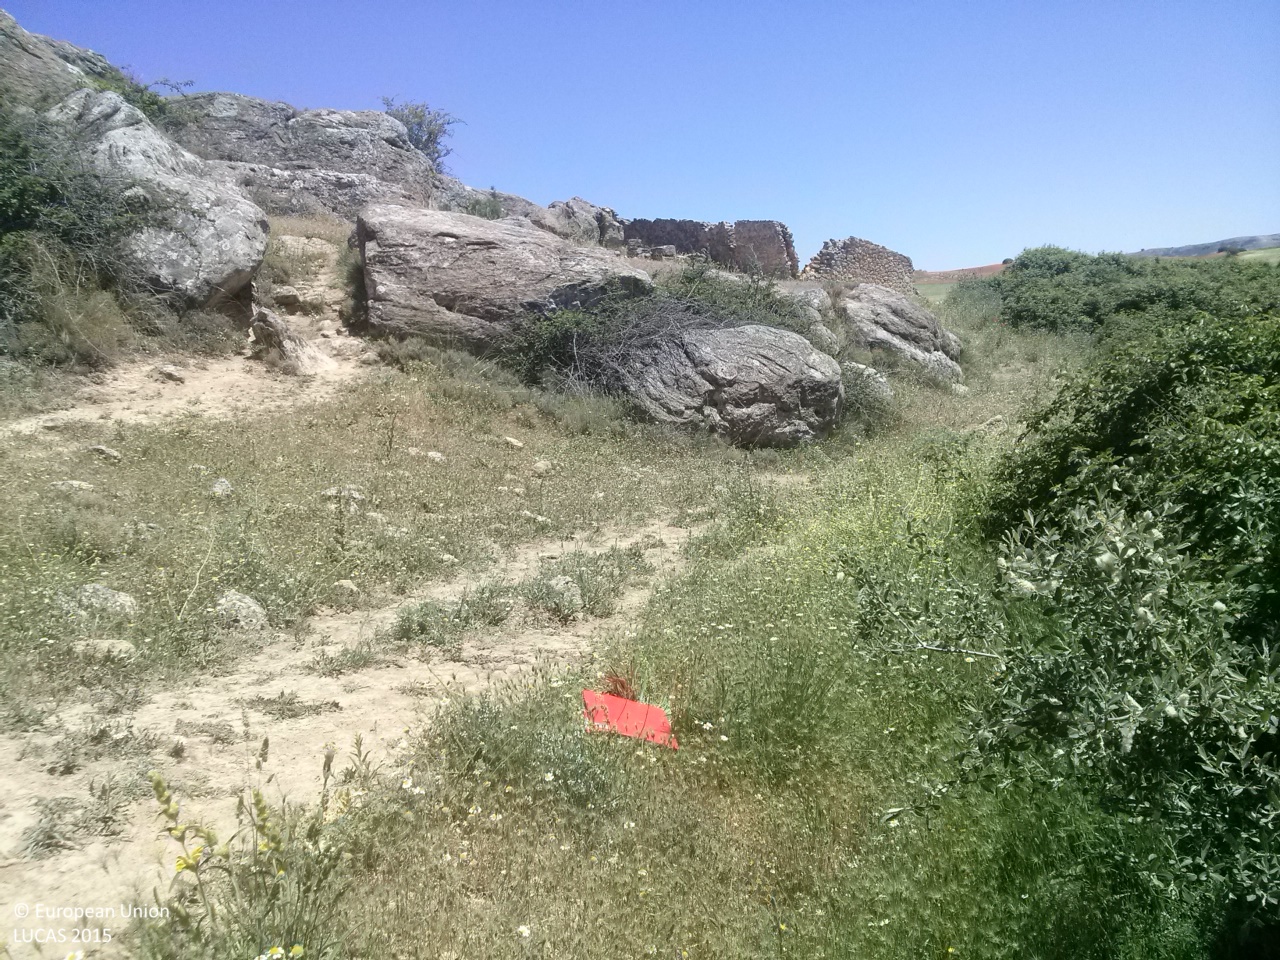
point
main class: Shrubland
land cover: Shrubland without tree cover
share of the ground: 25 - 50 %
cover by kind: shrubs 50 %, herbaceous plants 30 %, unconsolidated bare surface 20 %
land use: Semi-natural and natural areas not in use
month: May
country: ES
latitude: 40.2718
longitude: -2.7604
